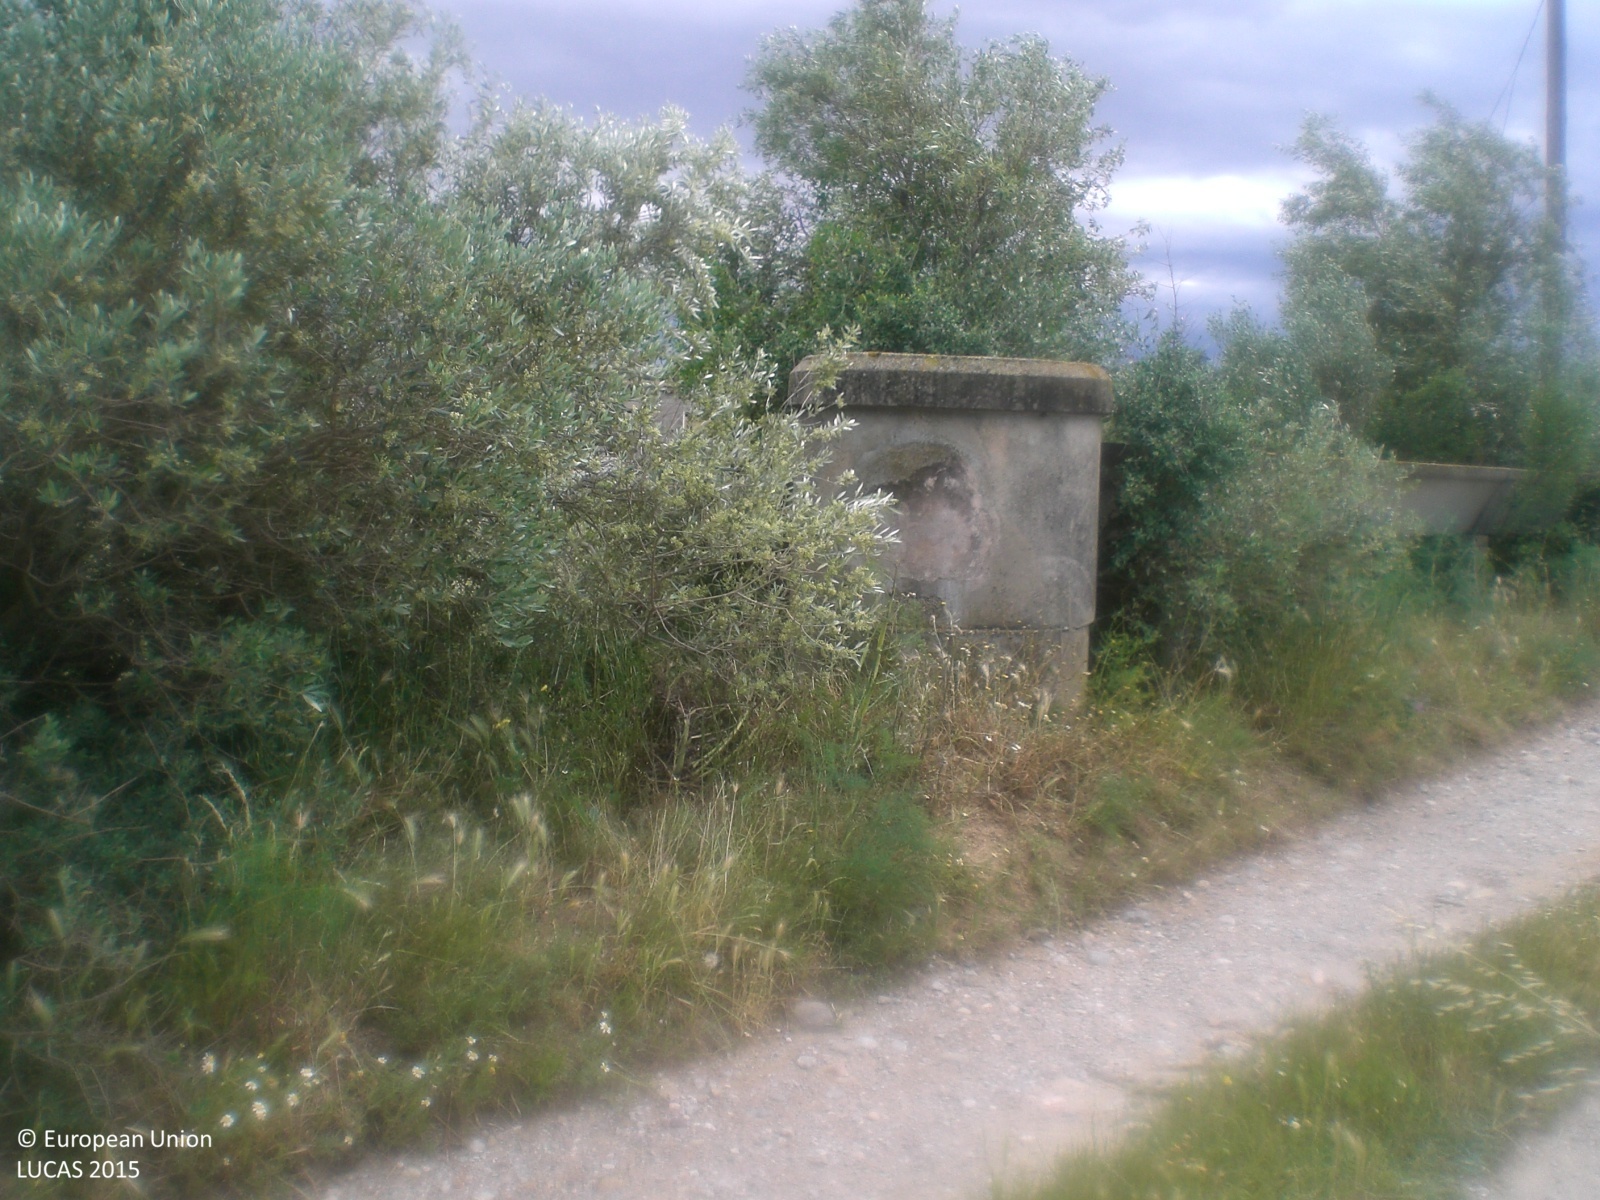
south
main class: Cropland
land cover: Other fruit trees and berries
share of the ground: 25 - 50 %
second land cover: Spontaneously vegetated surfaces
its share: 50 - 75 %
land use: Agriculture (excluding fallow land and kitchen gardens)
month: May
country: ES
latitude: 42.3186
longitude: 2.9644
